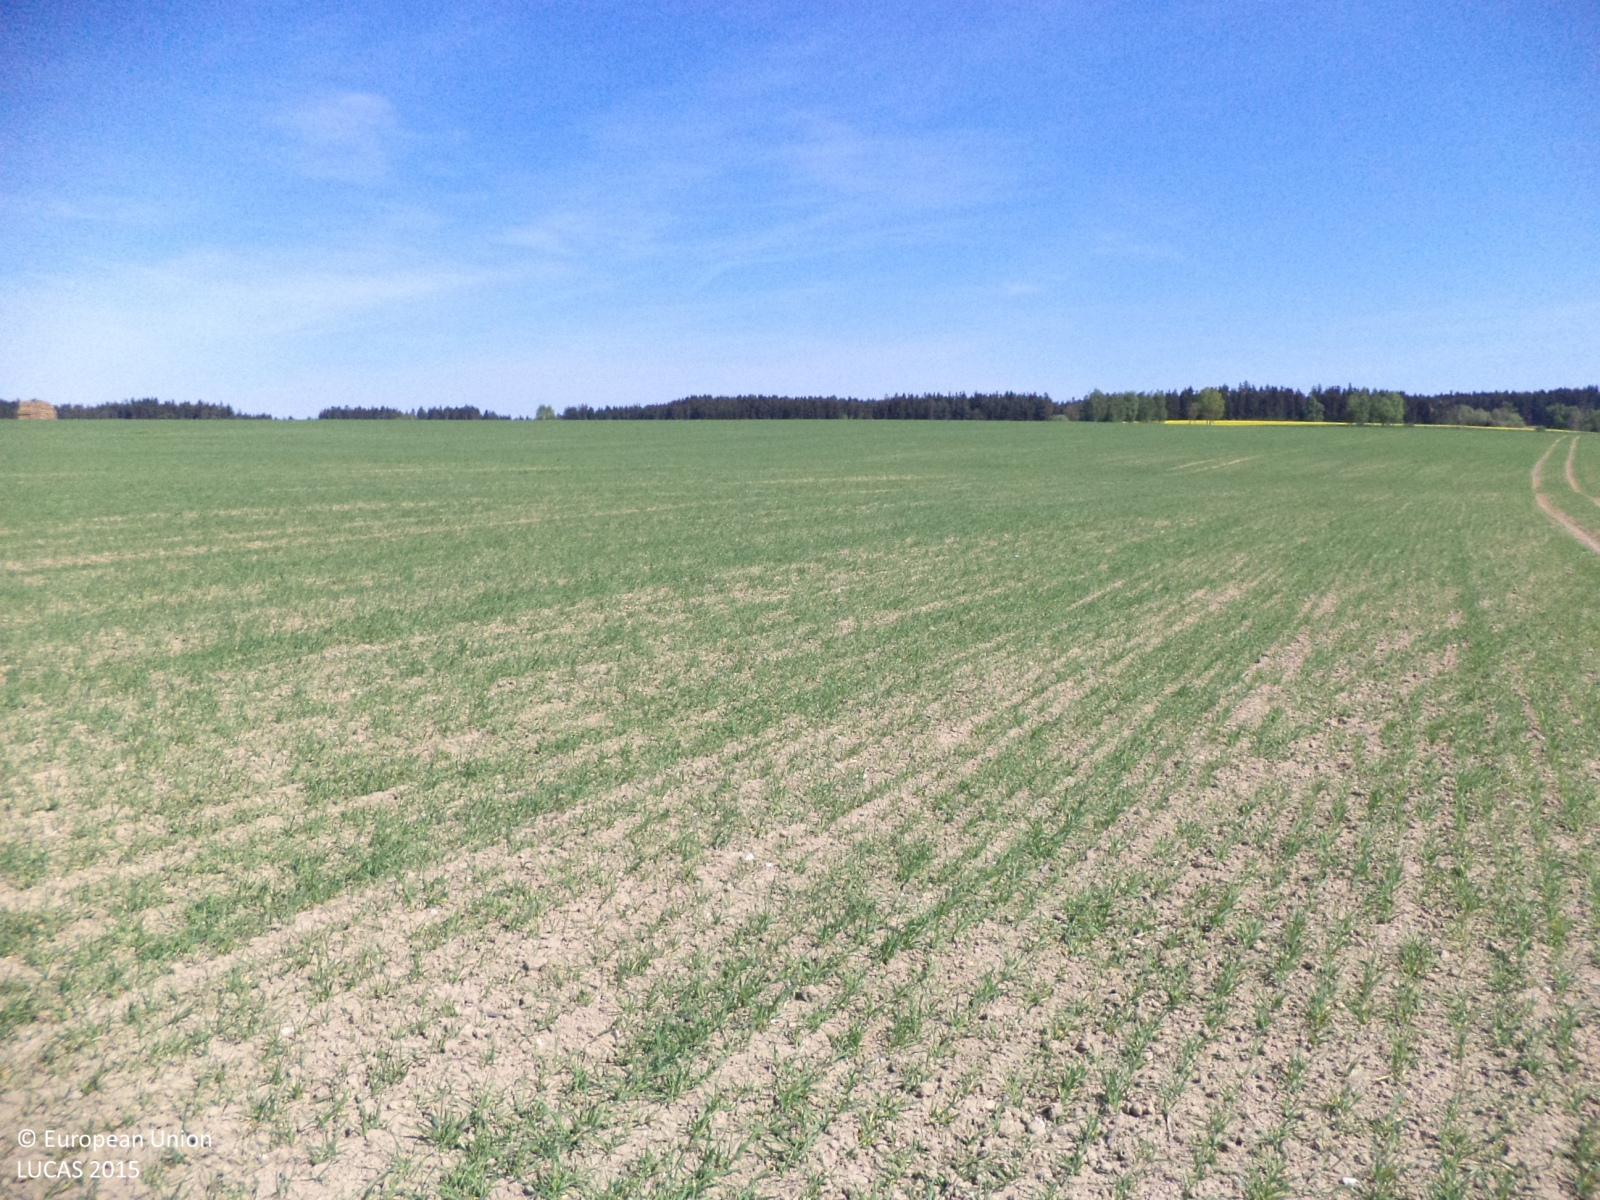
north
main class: Cropland
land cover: Barley
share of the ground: 25 - 50 %
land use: Agriculture (excluding fallow land and kitchen gardens)
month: May
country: CZ
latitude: 49.2580
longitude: 15.1277
